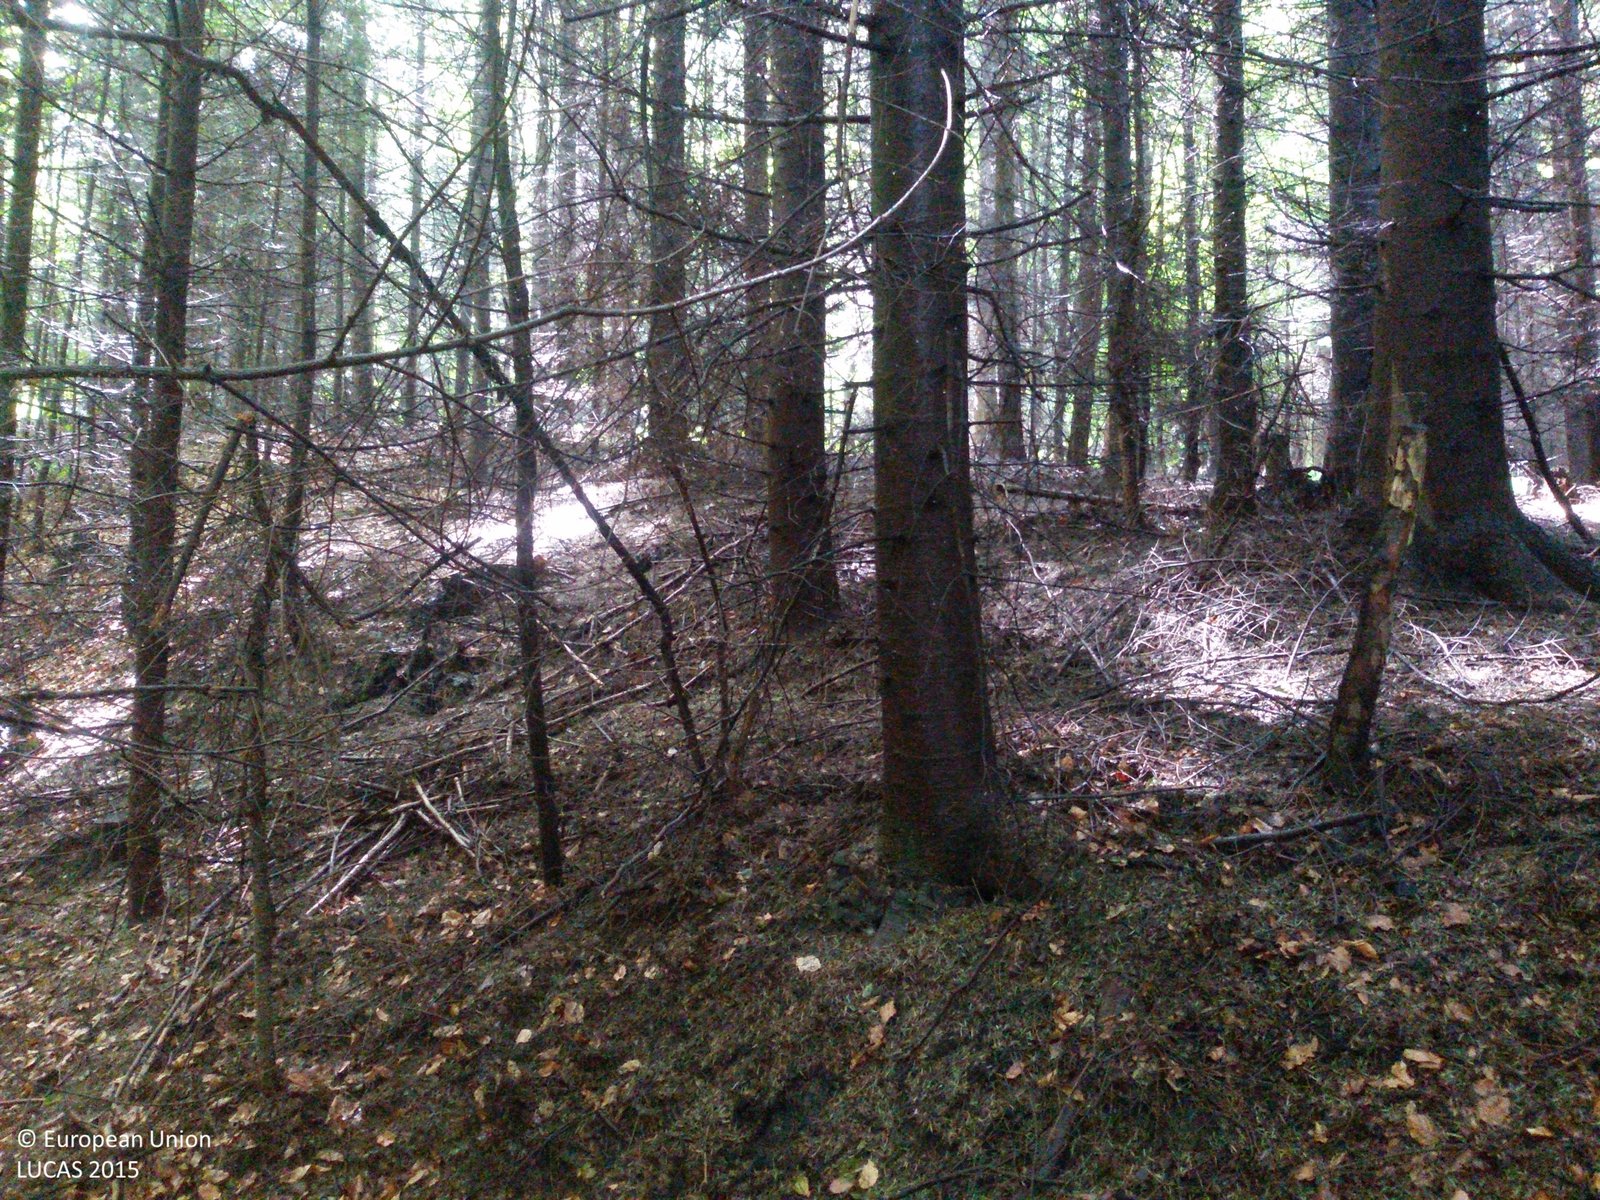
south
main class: Woodland
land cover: Spruce dominated mixed woodland
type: hemiboreal forest and nemoral coniferous forest and mixed broadleaved-coniferous forest
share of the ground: > 75 %
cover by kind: coniferous forest trees 70 %, broadleaved forest trees 25 %, unconsolidated bare surface 5 %
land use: Forestry
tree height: > 5 m
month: July
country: PL
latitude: 49.8982
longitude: 20.2954
